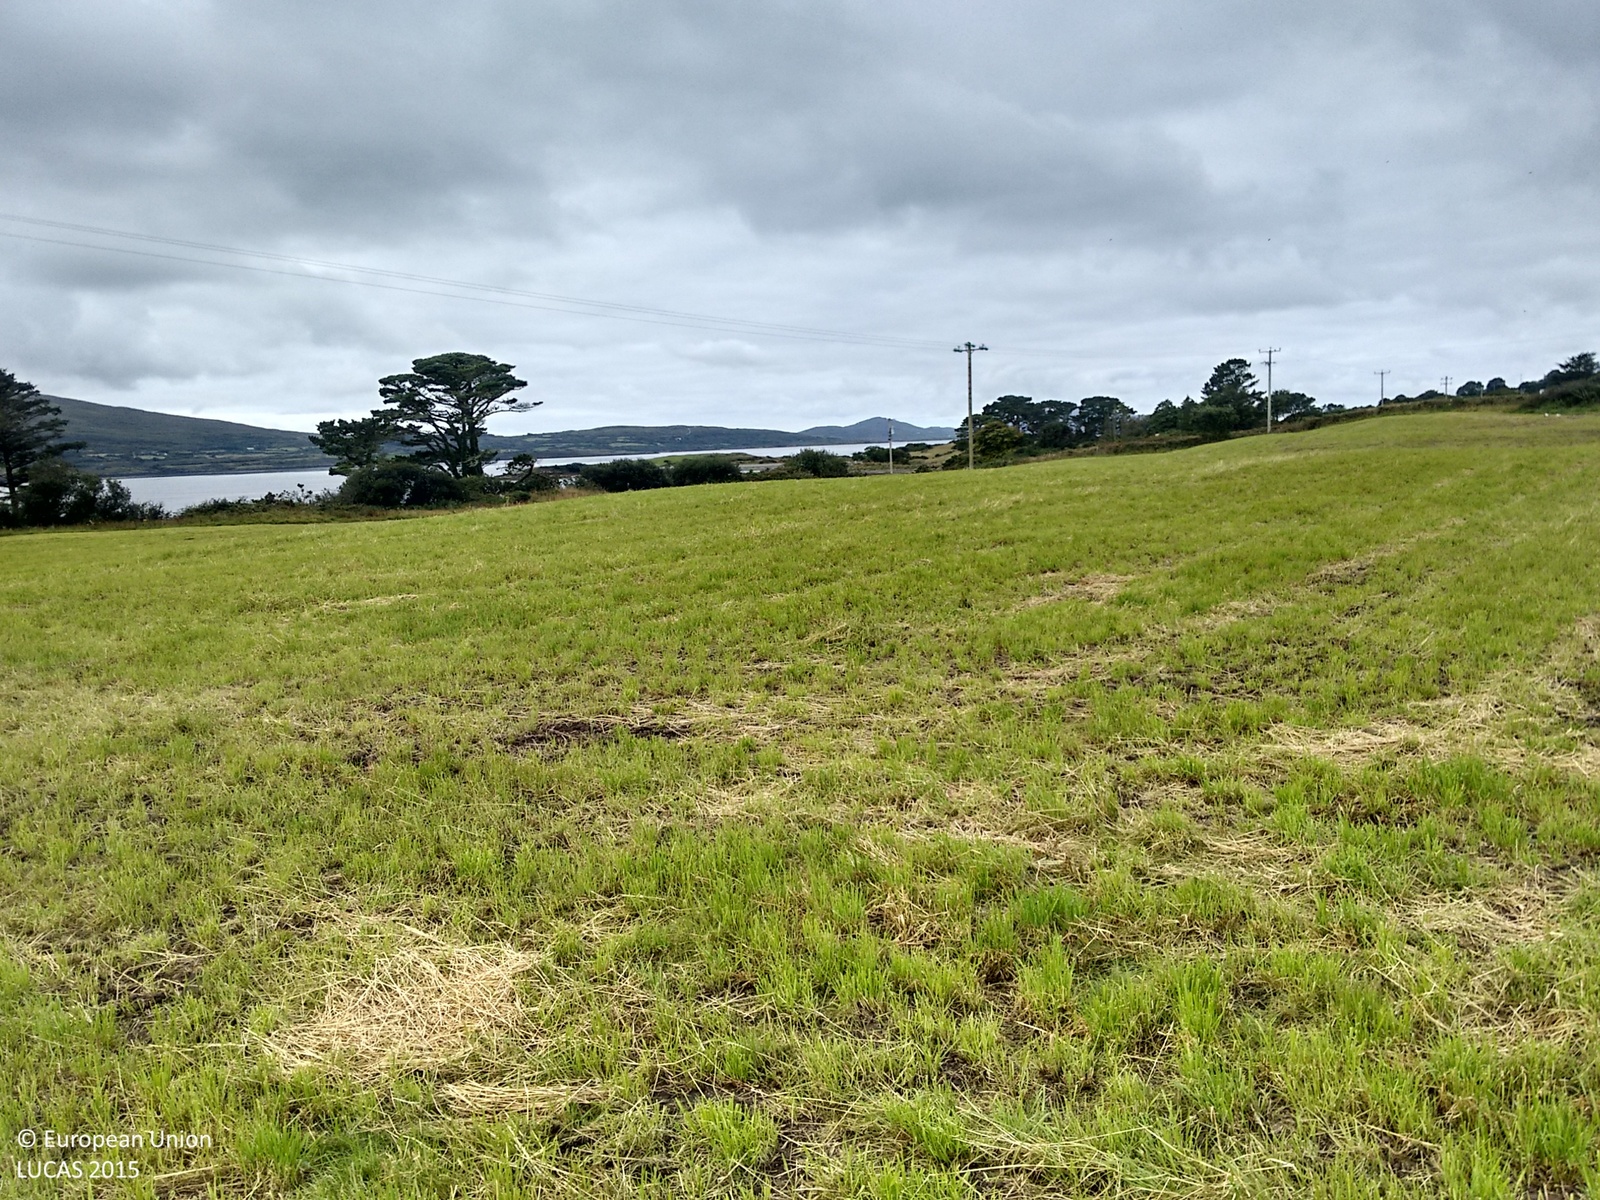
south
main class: Grassland
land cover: Grassland without tree/shrub cover
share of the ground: > 75 %
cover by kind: herbaceous plants 95 %, shrubs 5 %
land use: Agriculture (excluding fallow land and kitchen gardens)
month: August
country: IE
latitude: 51.6086
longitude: -9.6008
